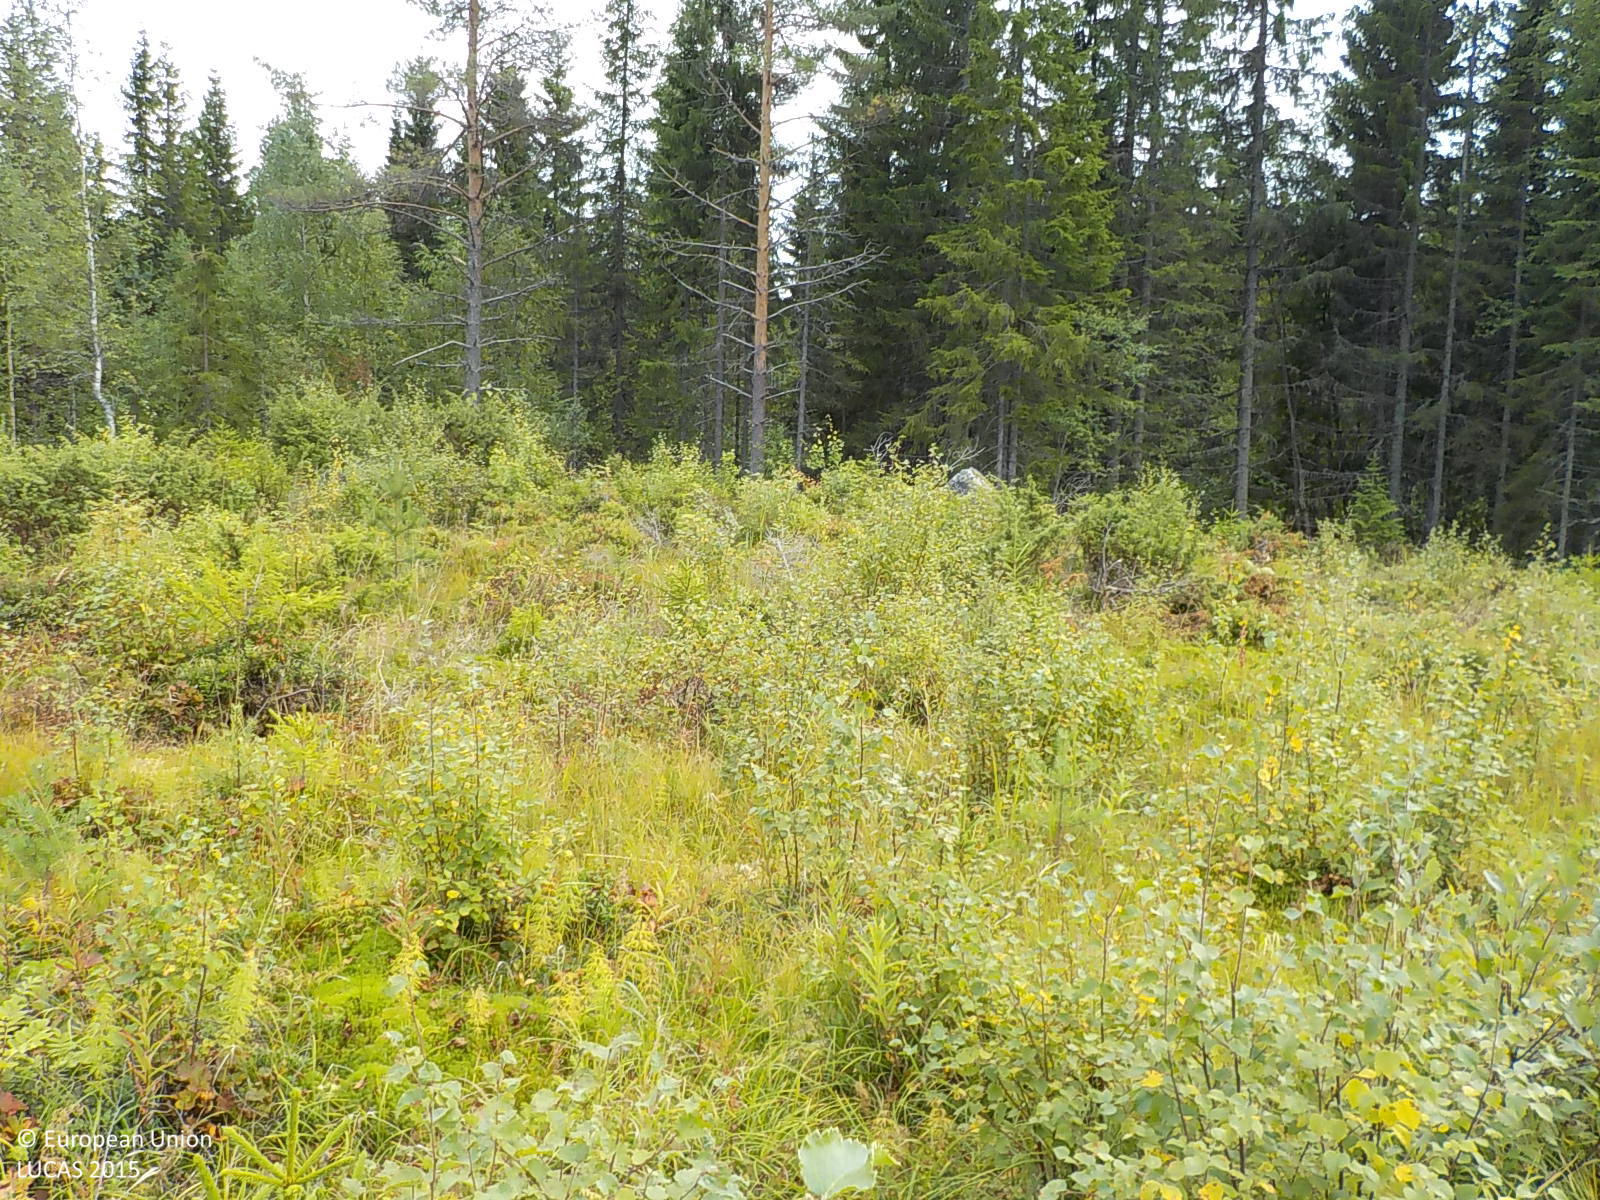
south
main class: Artificial land
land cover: Other artificial areas
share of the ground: 50 - 75 %
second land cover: Broadleaved woodland
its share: 25 - 50 %
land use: Electricity, gas and thermal power distribution
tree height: < 5 m
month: September
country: SE
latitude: 63.2841
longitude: 17.7314
